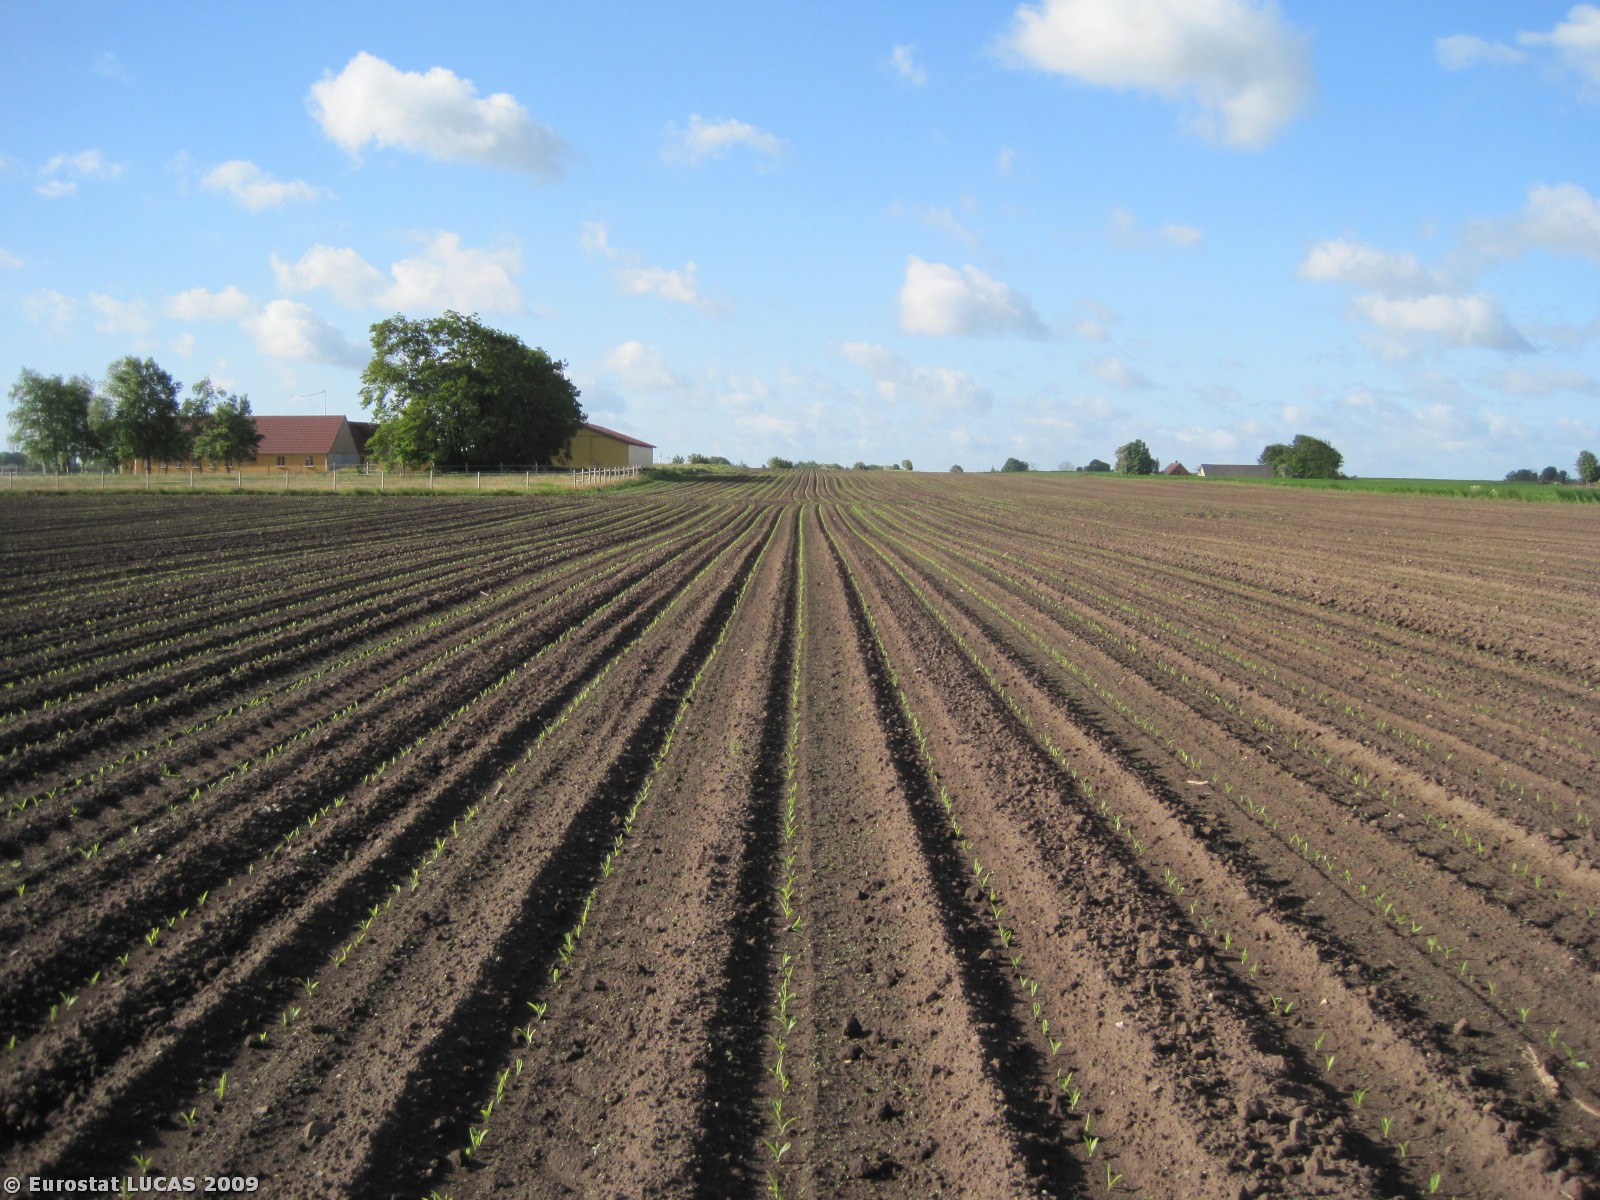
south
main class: Cropland
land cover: Maize
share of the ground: < 10 %
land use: Agriculture (excluding fallow land and kitchen gardens)
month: May
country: DK
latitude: 56.5109
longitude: 9.6917
